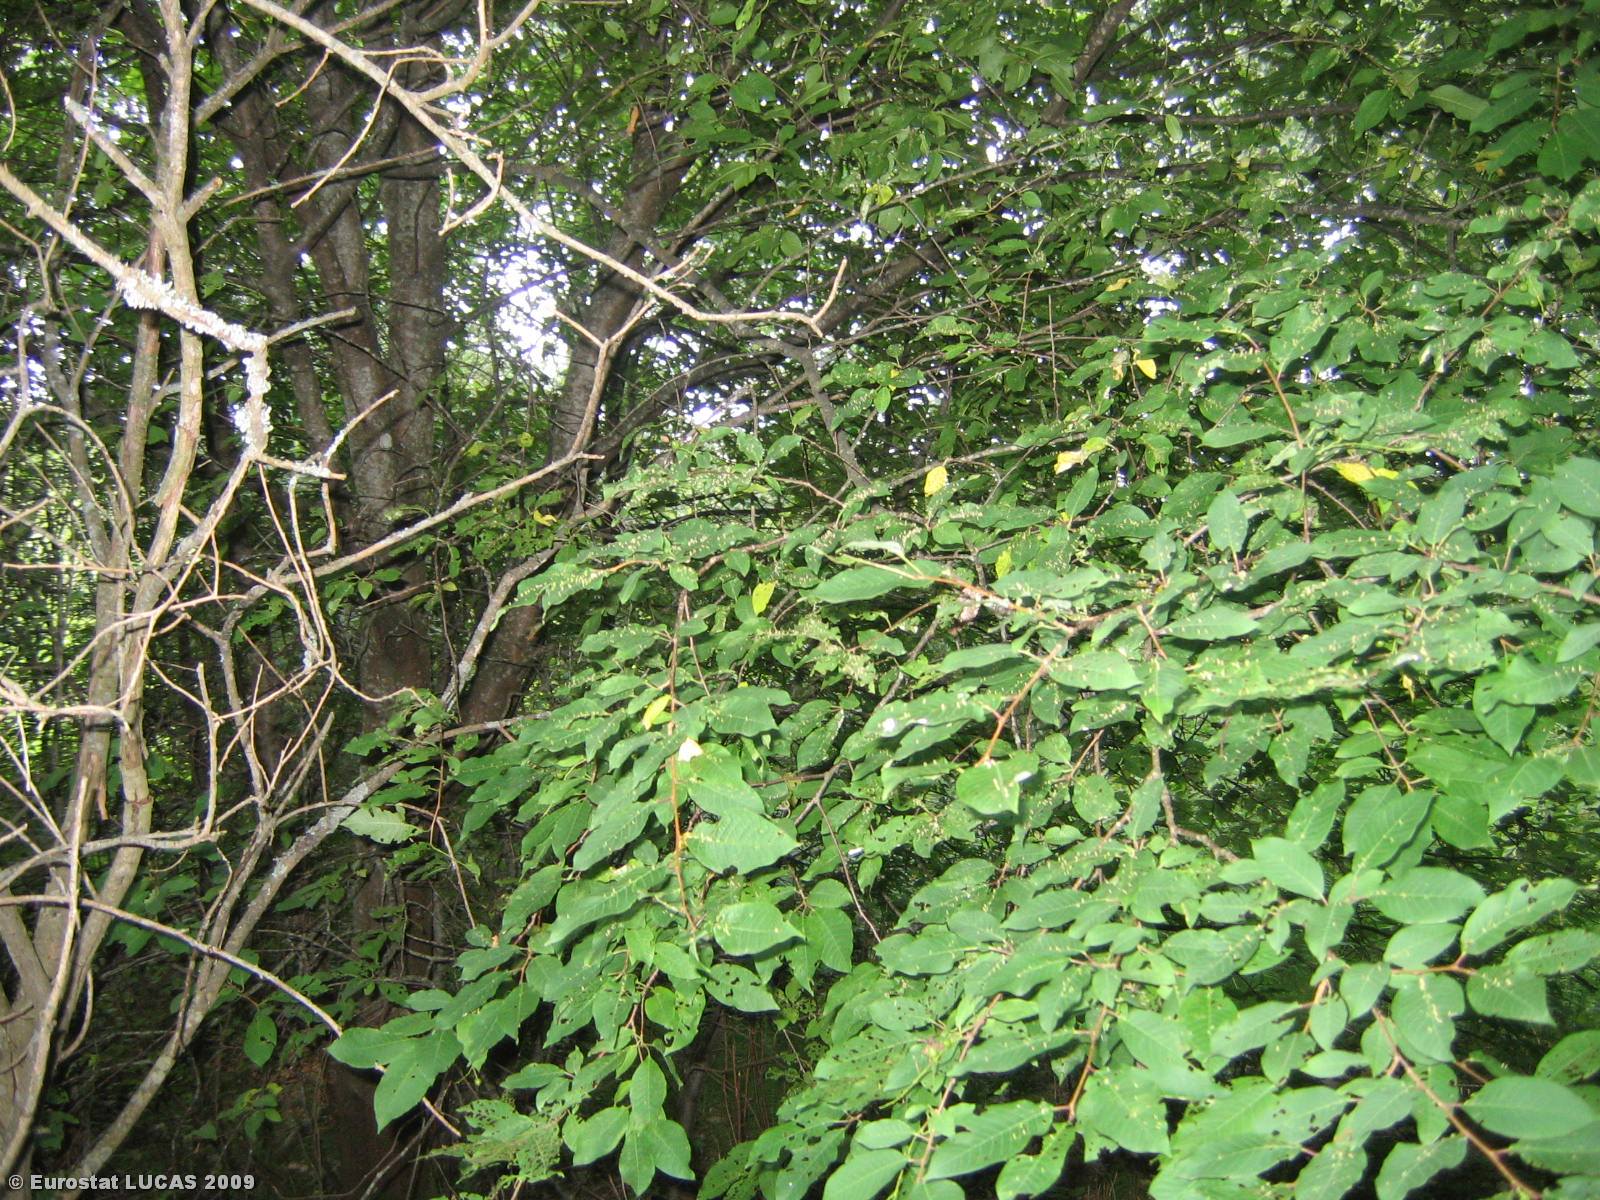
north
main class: Woodland
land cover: Broadleaved woodland
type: non-riverine alder, birch or aspen forest
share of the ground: > 75 %
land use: Forestry
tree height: > 5 m
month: July
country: LT
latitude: 55.4238
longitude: 22.7209
